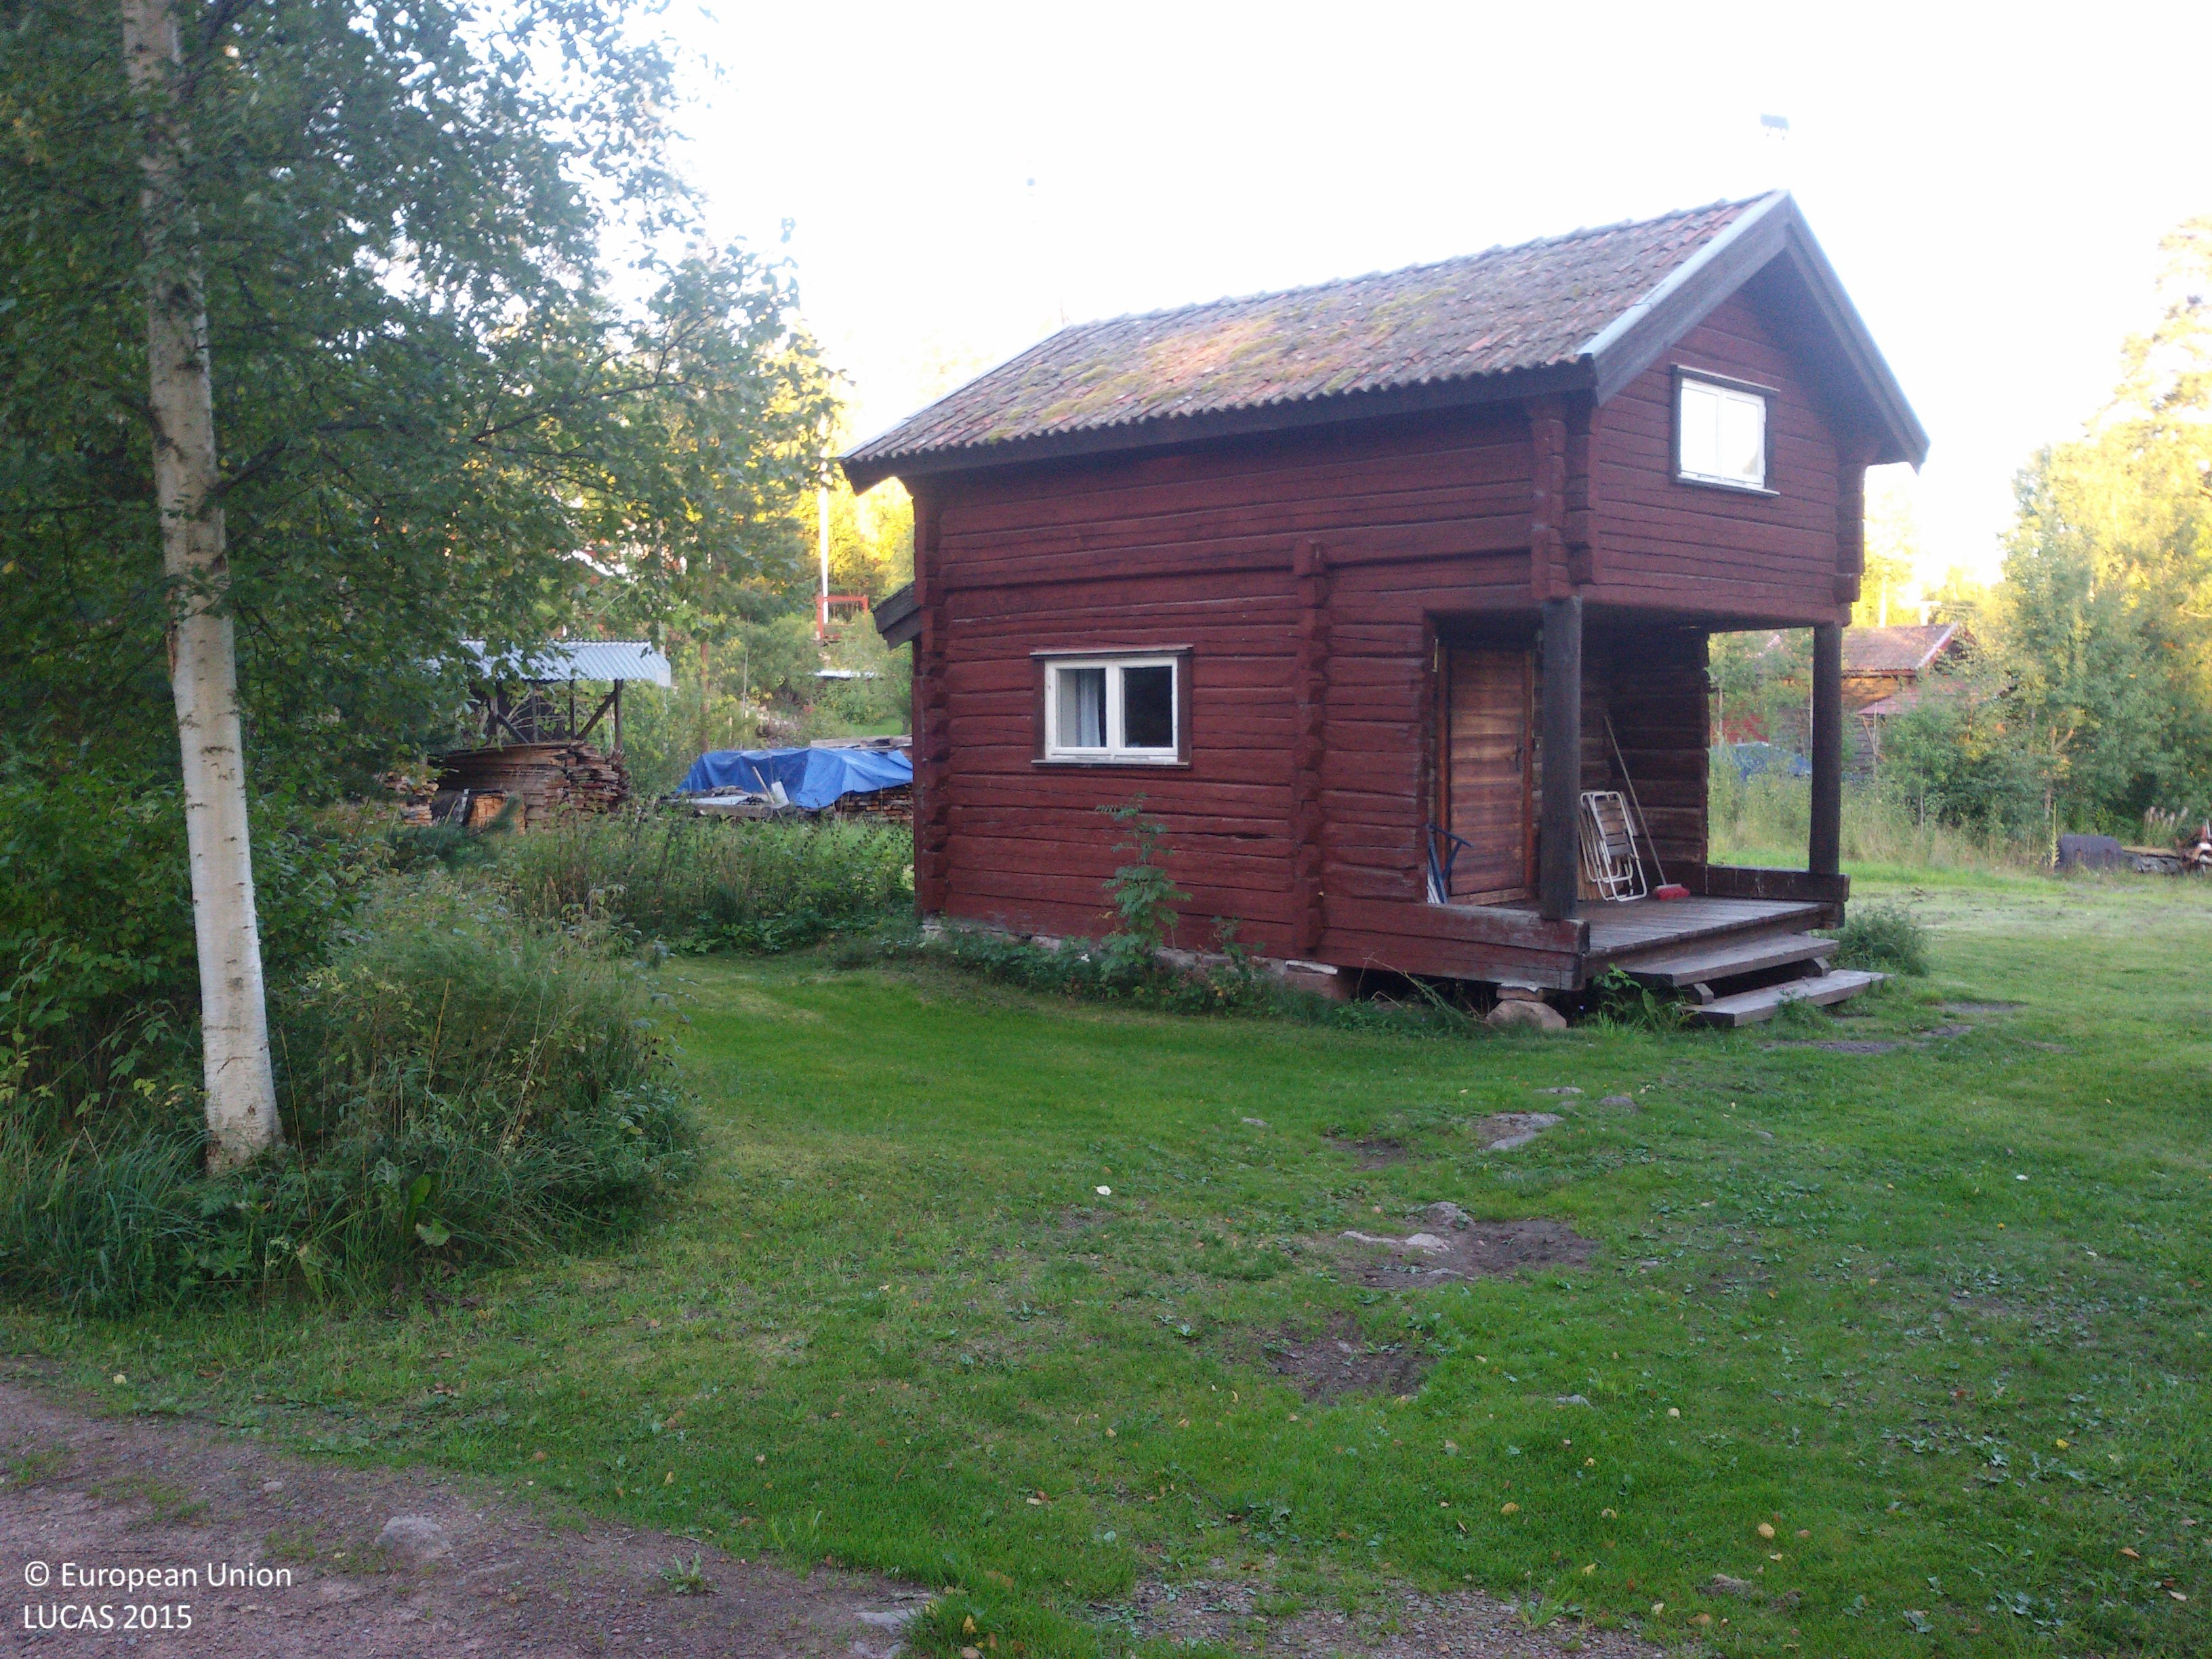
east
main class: Grassland
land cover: Grassland without tree/shrub cover
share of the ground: > 75 %
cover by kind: herbaceous plants 100 %
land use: Residential
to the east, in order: Grassland without tree/shrub cover; Artificial constructions in urban areas
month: September
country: SE
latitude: 60.9021
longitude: 15.0558
